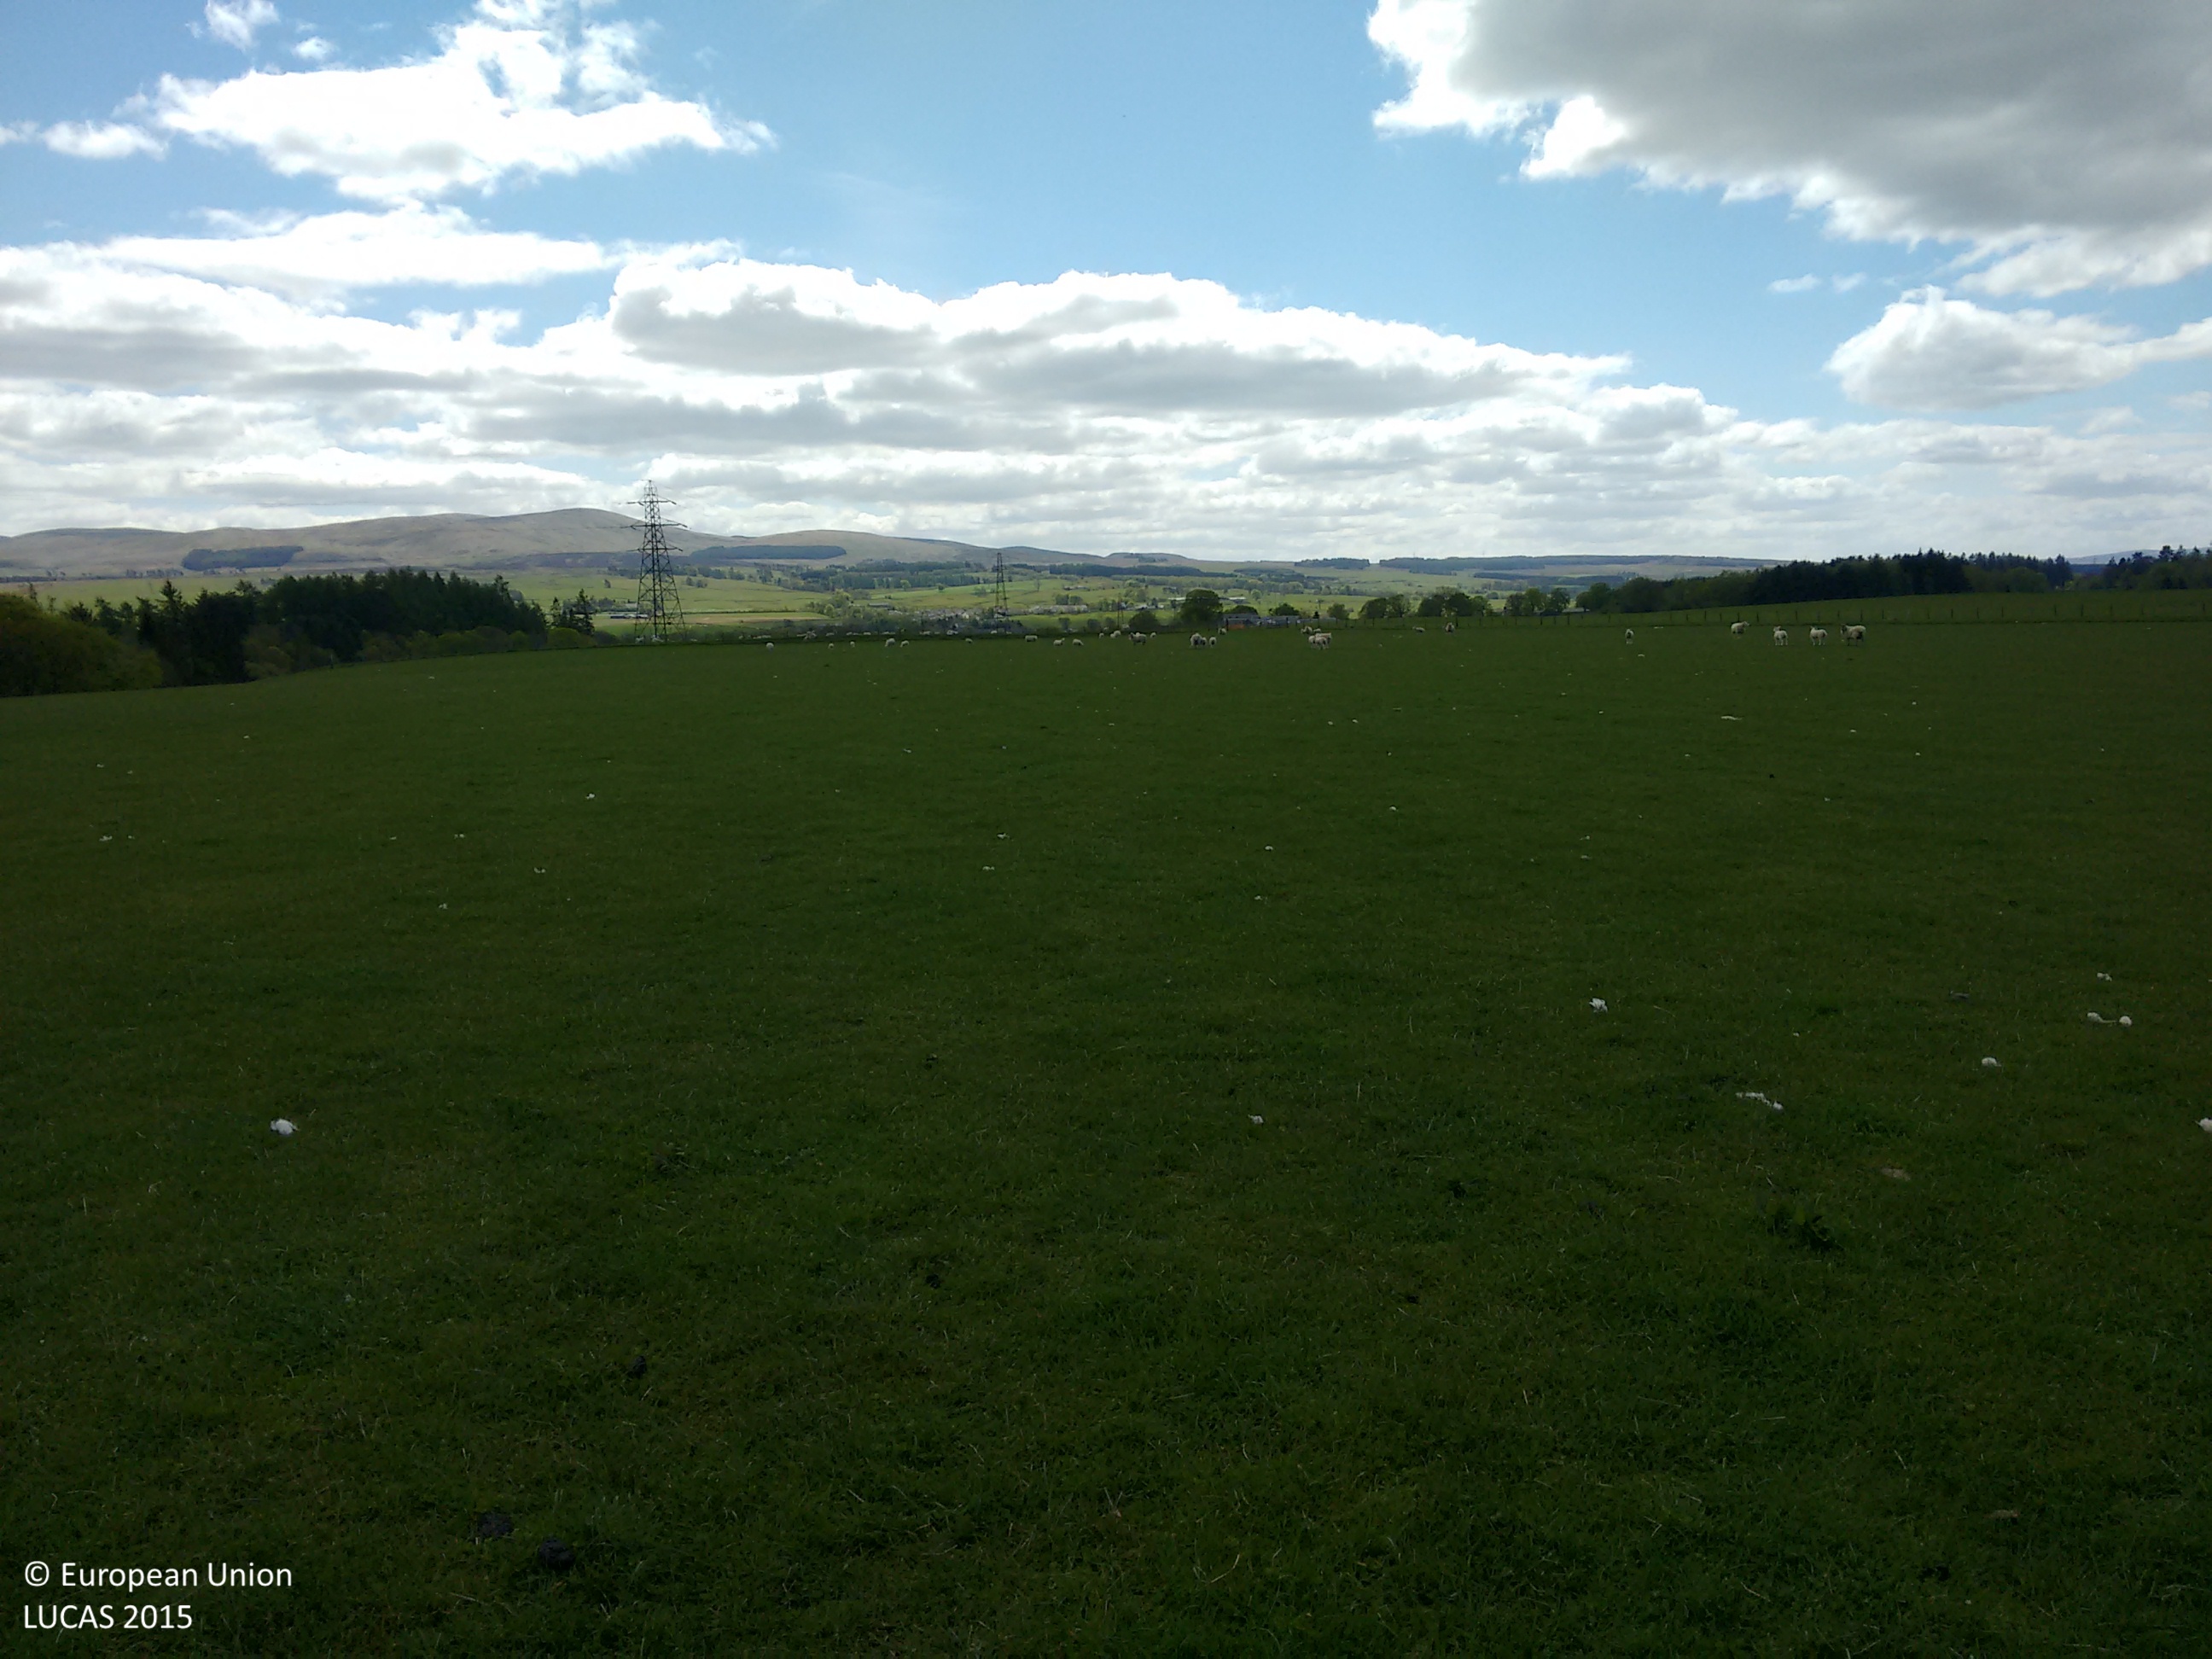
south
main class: Grassland
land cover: Grassland without tree/shrub cover
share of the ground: > 75 %
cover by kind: herbaceous plants 100 %
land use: Agriculture (excluding fallow land and kitchen gardens)
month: May
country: GB
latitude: 56.2681
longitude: -3.8894
